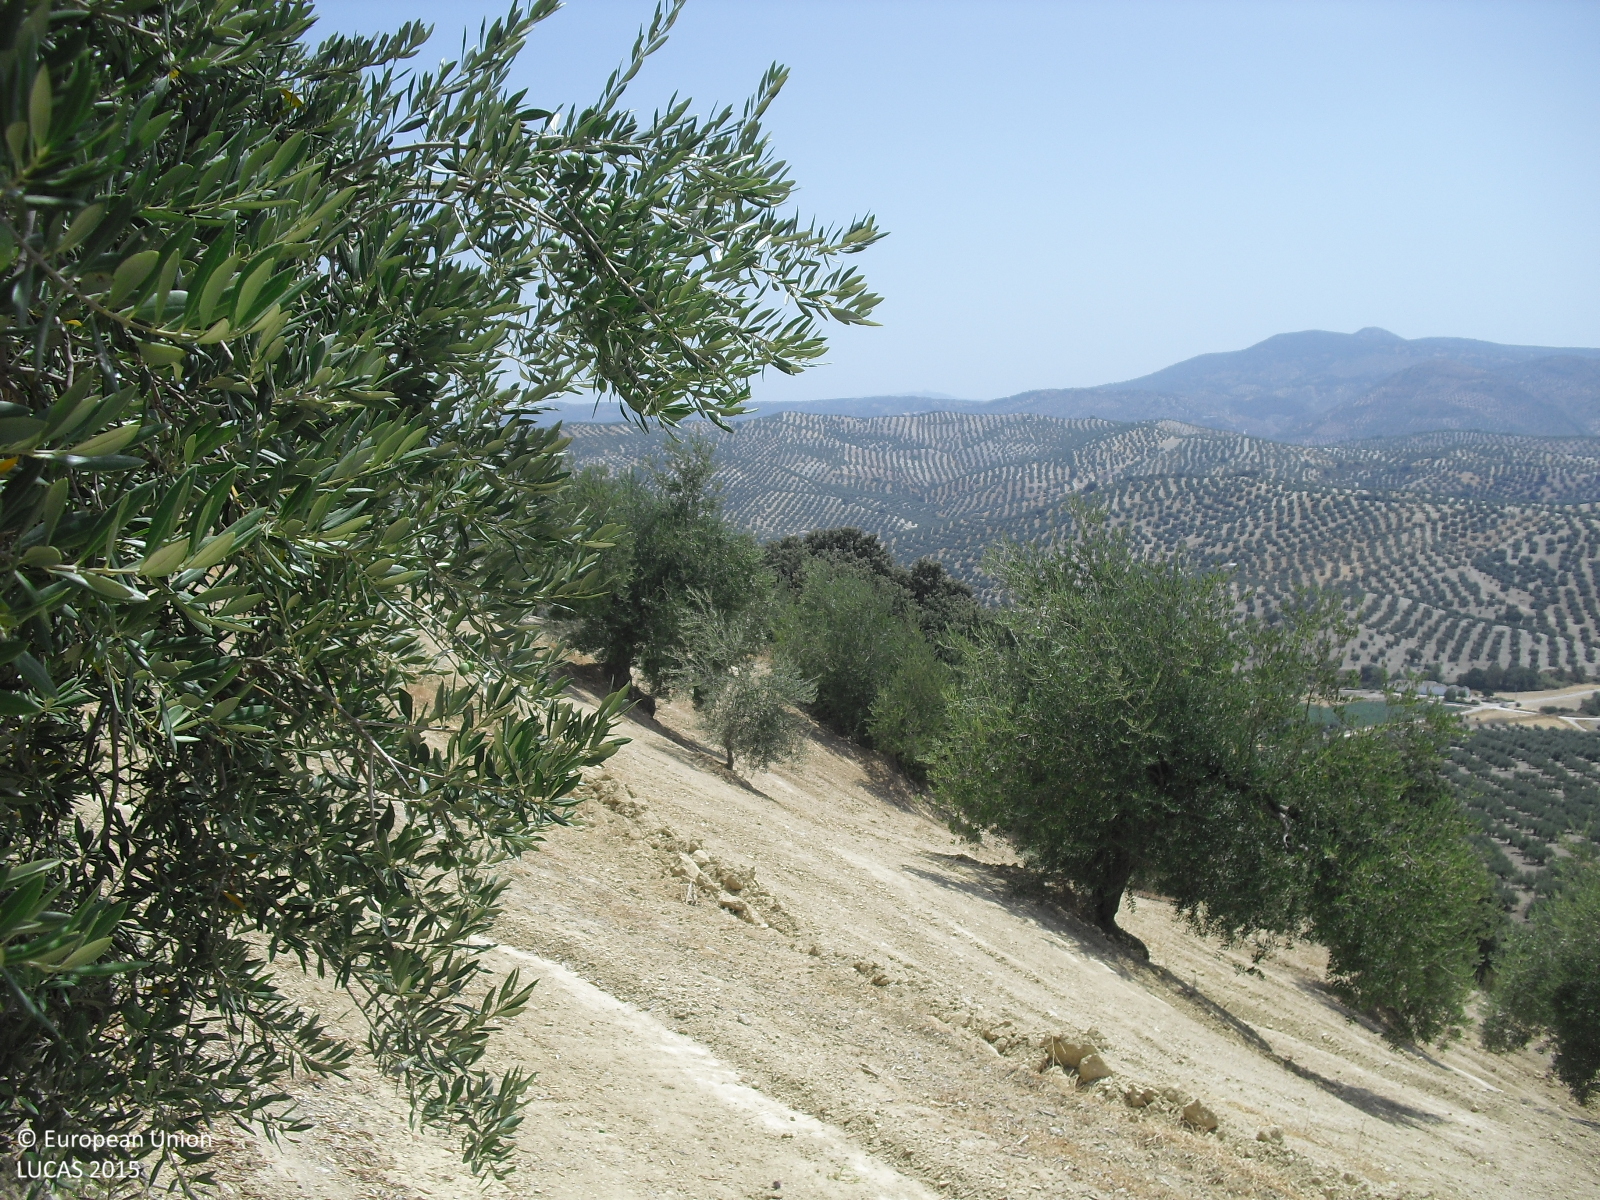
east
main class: Cropland
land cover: Olive groves
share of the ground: 10 - 25 %
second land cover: Other bare soil
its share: > 75 %
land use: Agriculture (excluding fallow land and kitchen gardens)
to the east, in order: Olive groves; Other bare soil; Broadleaved woodland; Olive groves; Broadleaved woodland; Olive groves
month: August
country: ES
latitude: 37.3365
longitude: -4.2084
